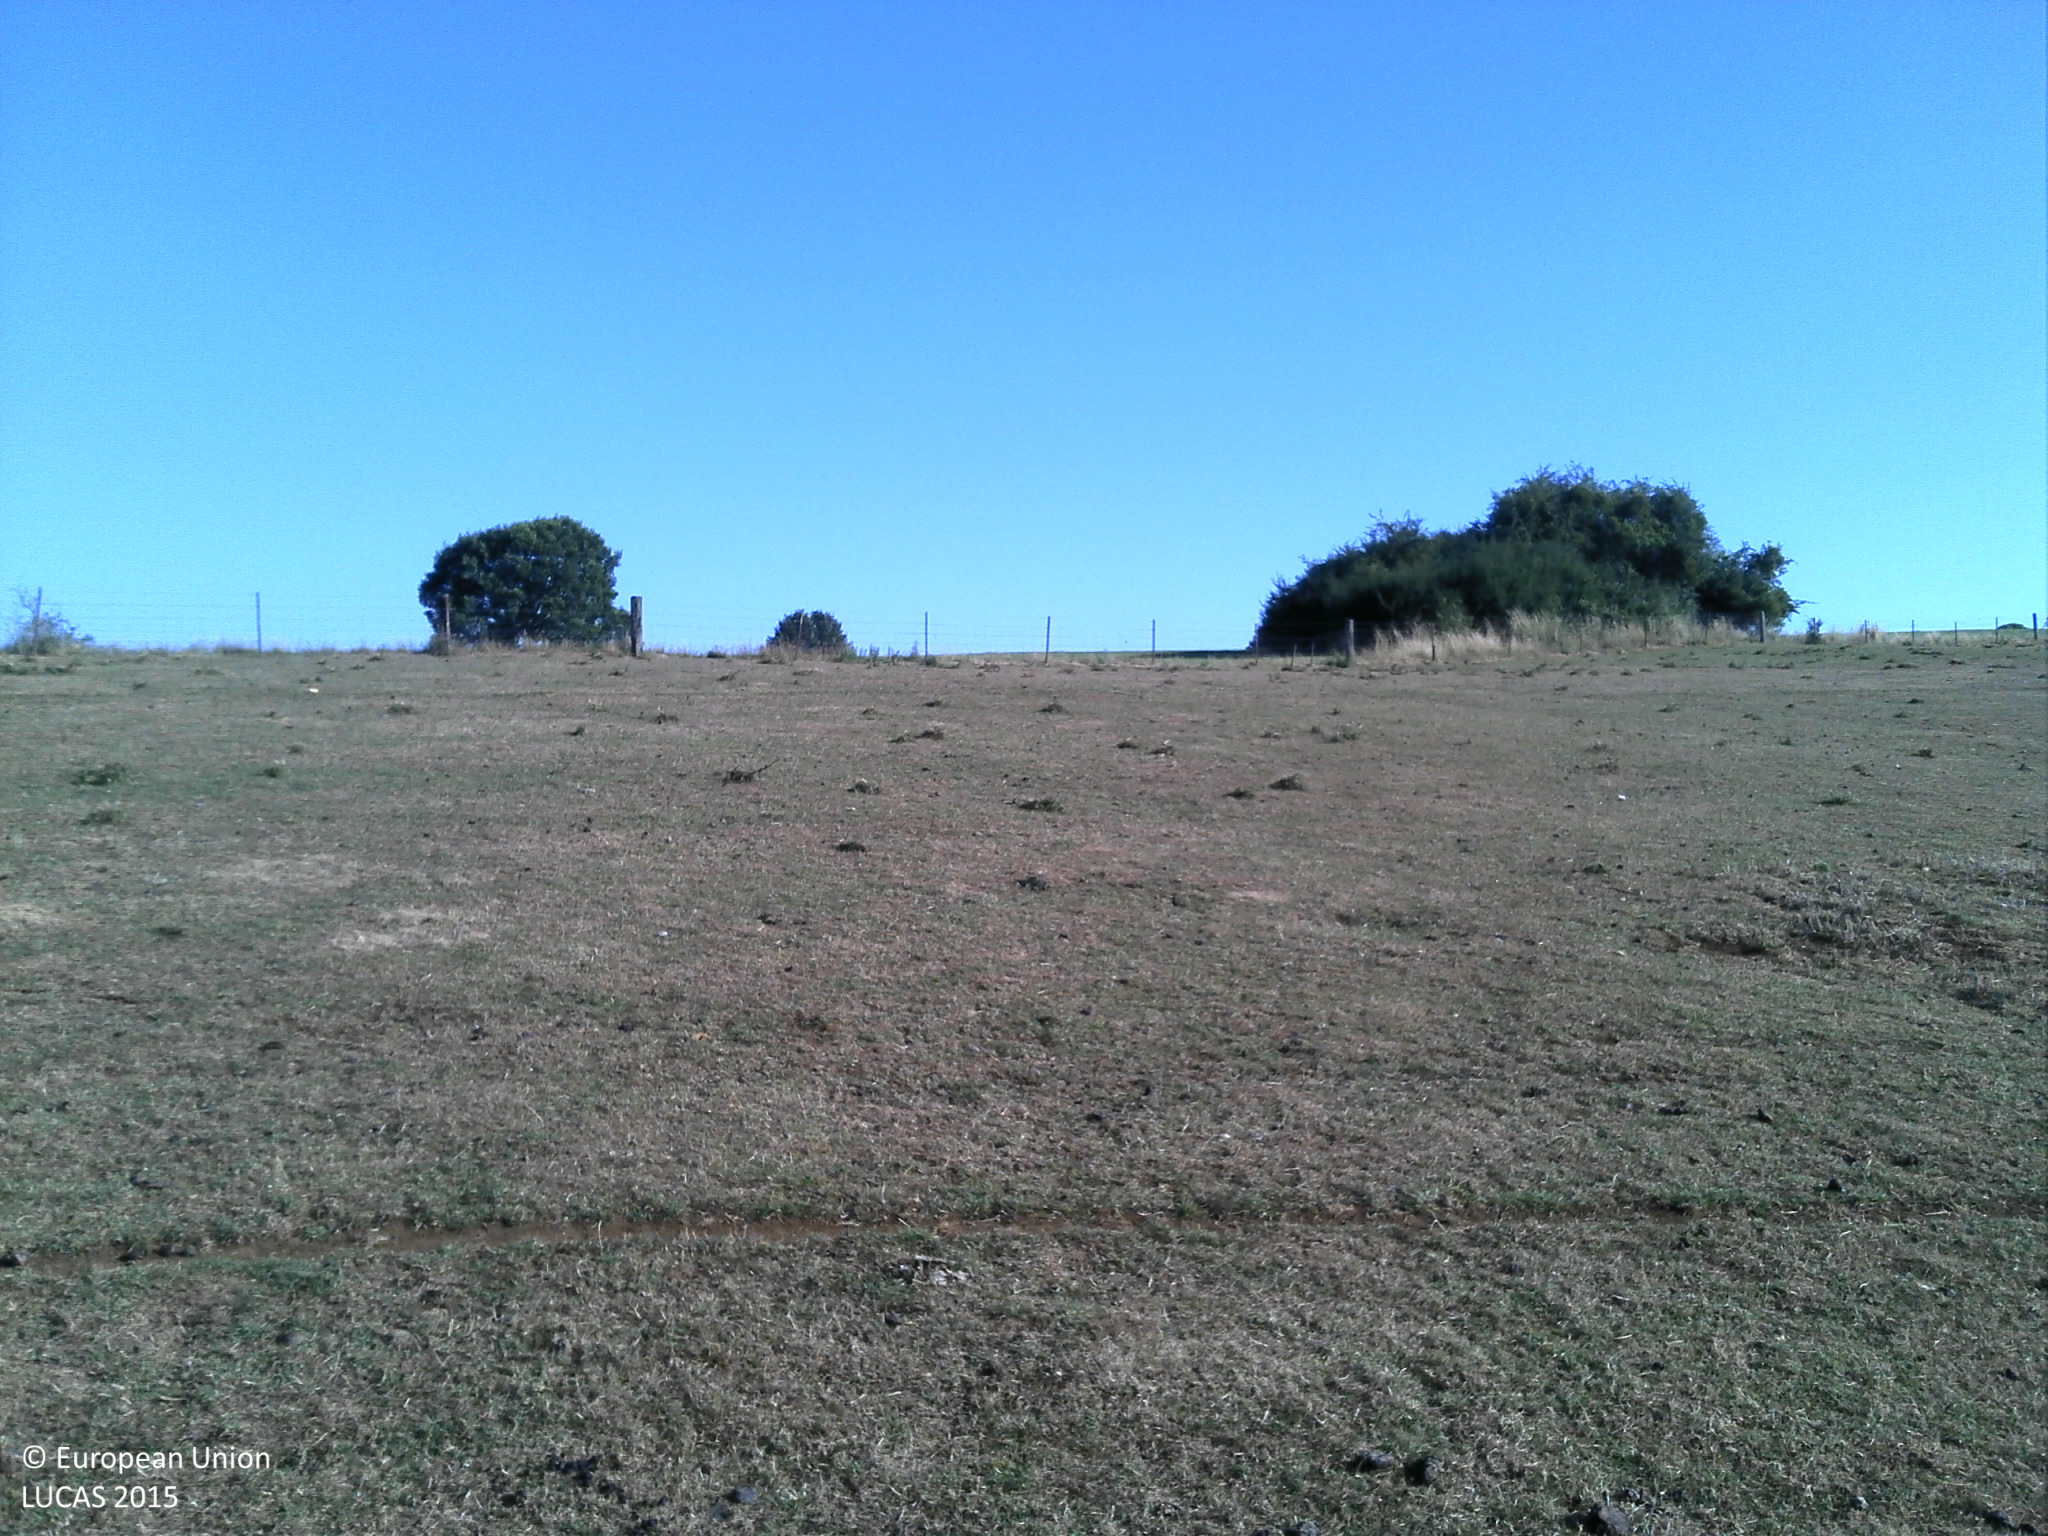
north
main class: Grassland
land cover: Grassland without tree/shrub cover
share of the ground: > 75 %
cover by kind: herbaceous plants 100 %
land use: Agriculture (excluding fallow land and kitchen gardens)
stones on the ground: < 10 %
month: July
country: FR
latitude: 49.6295
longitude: 4.7220
